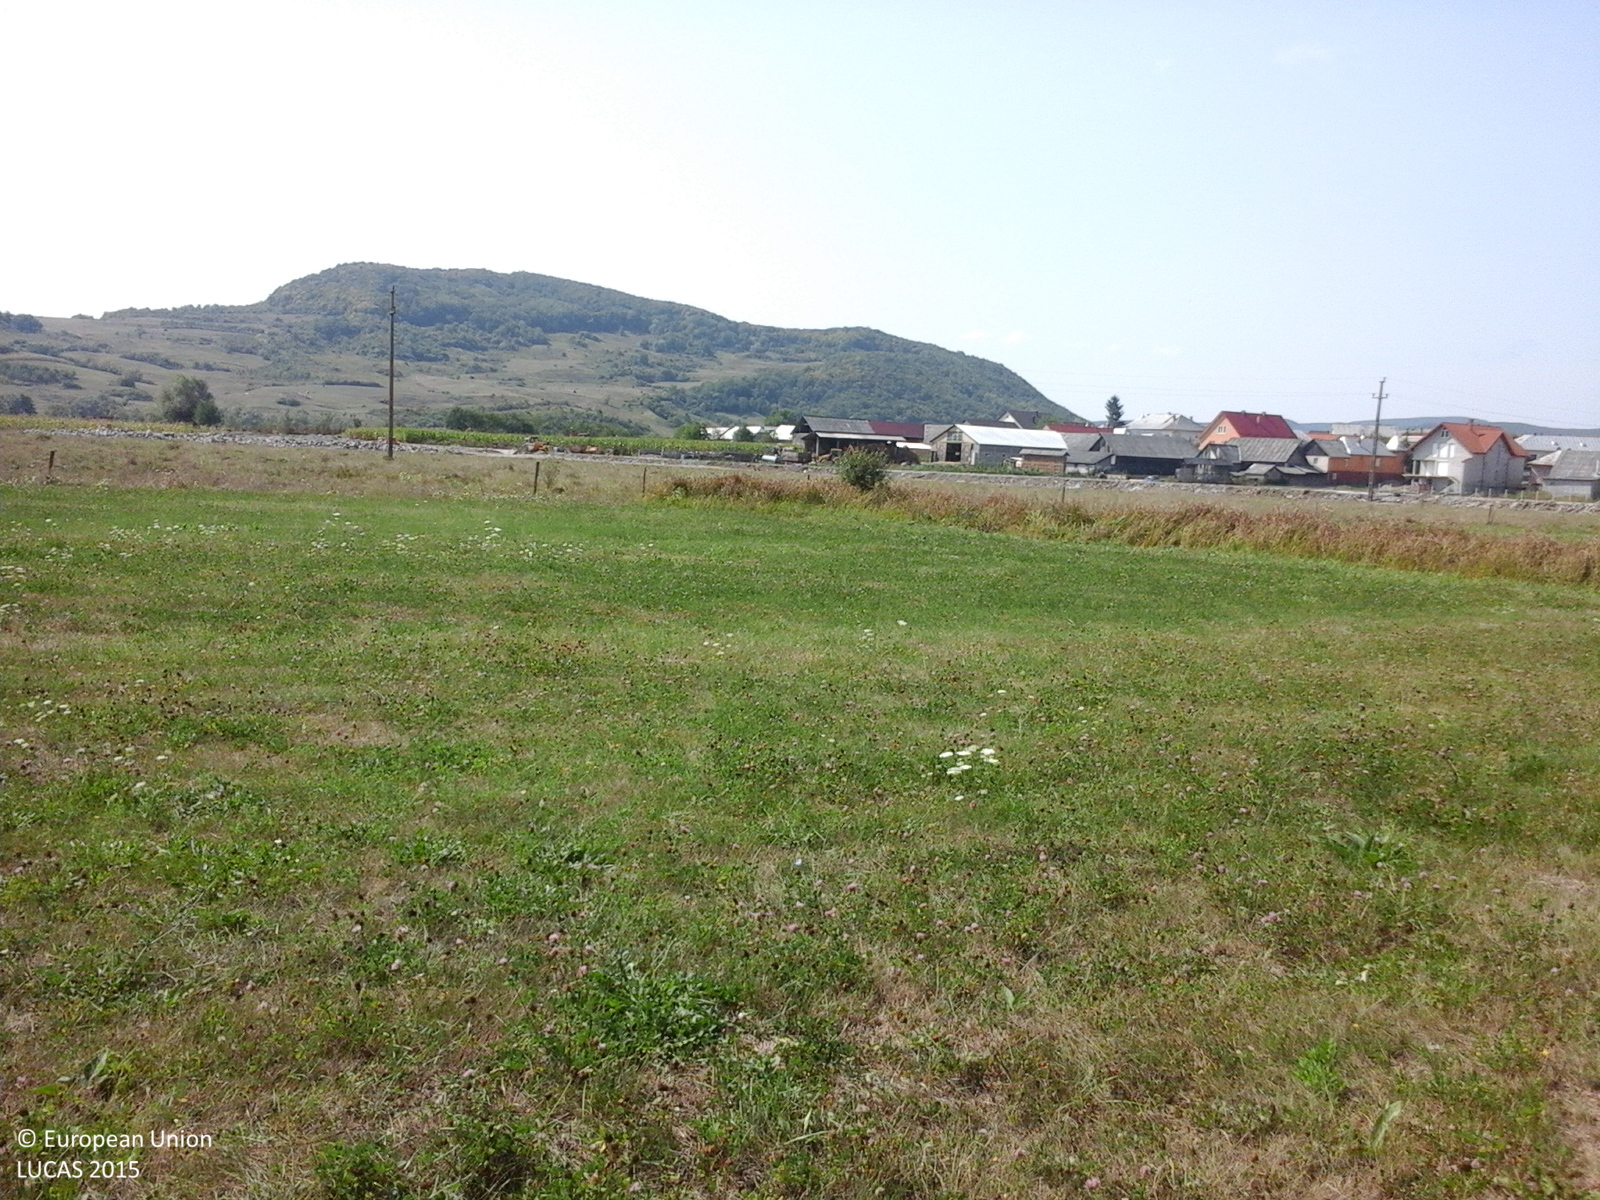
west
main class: Grassland
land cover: Grassland without tree/shrub cover
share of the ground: > 75 %
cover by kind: herbaceous plants 100 %
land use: Agriculture (excluding fallow land and kitchen gardens)
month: September
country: RO
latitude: 47.2317
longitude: 24.1514
